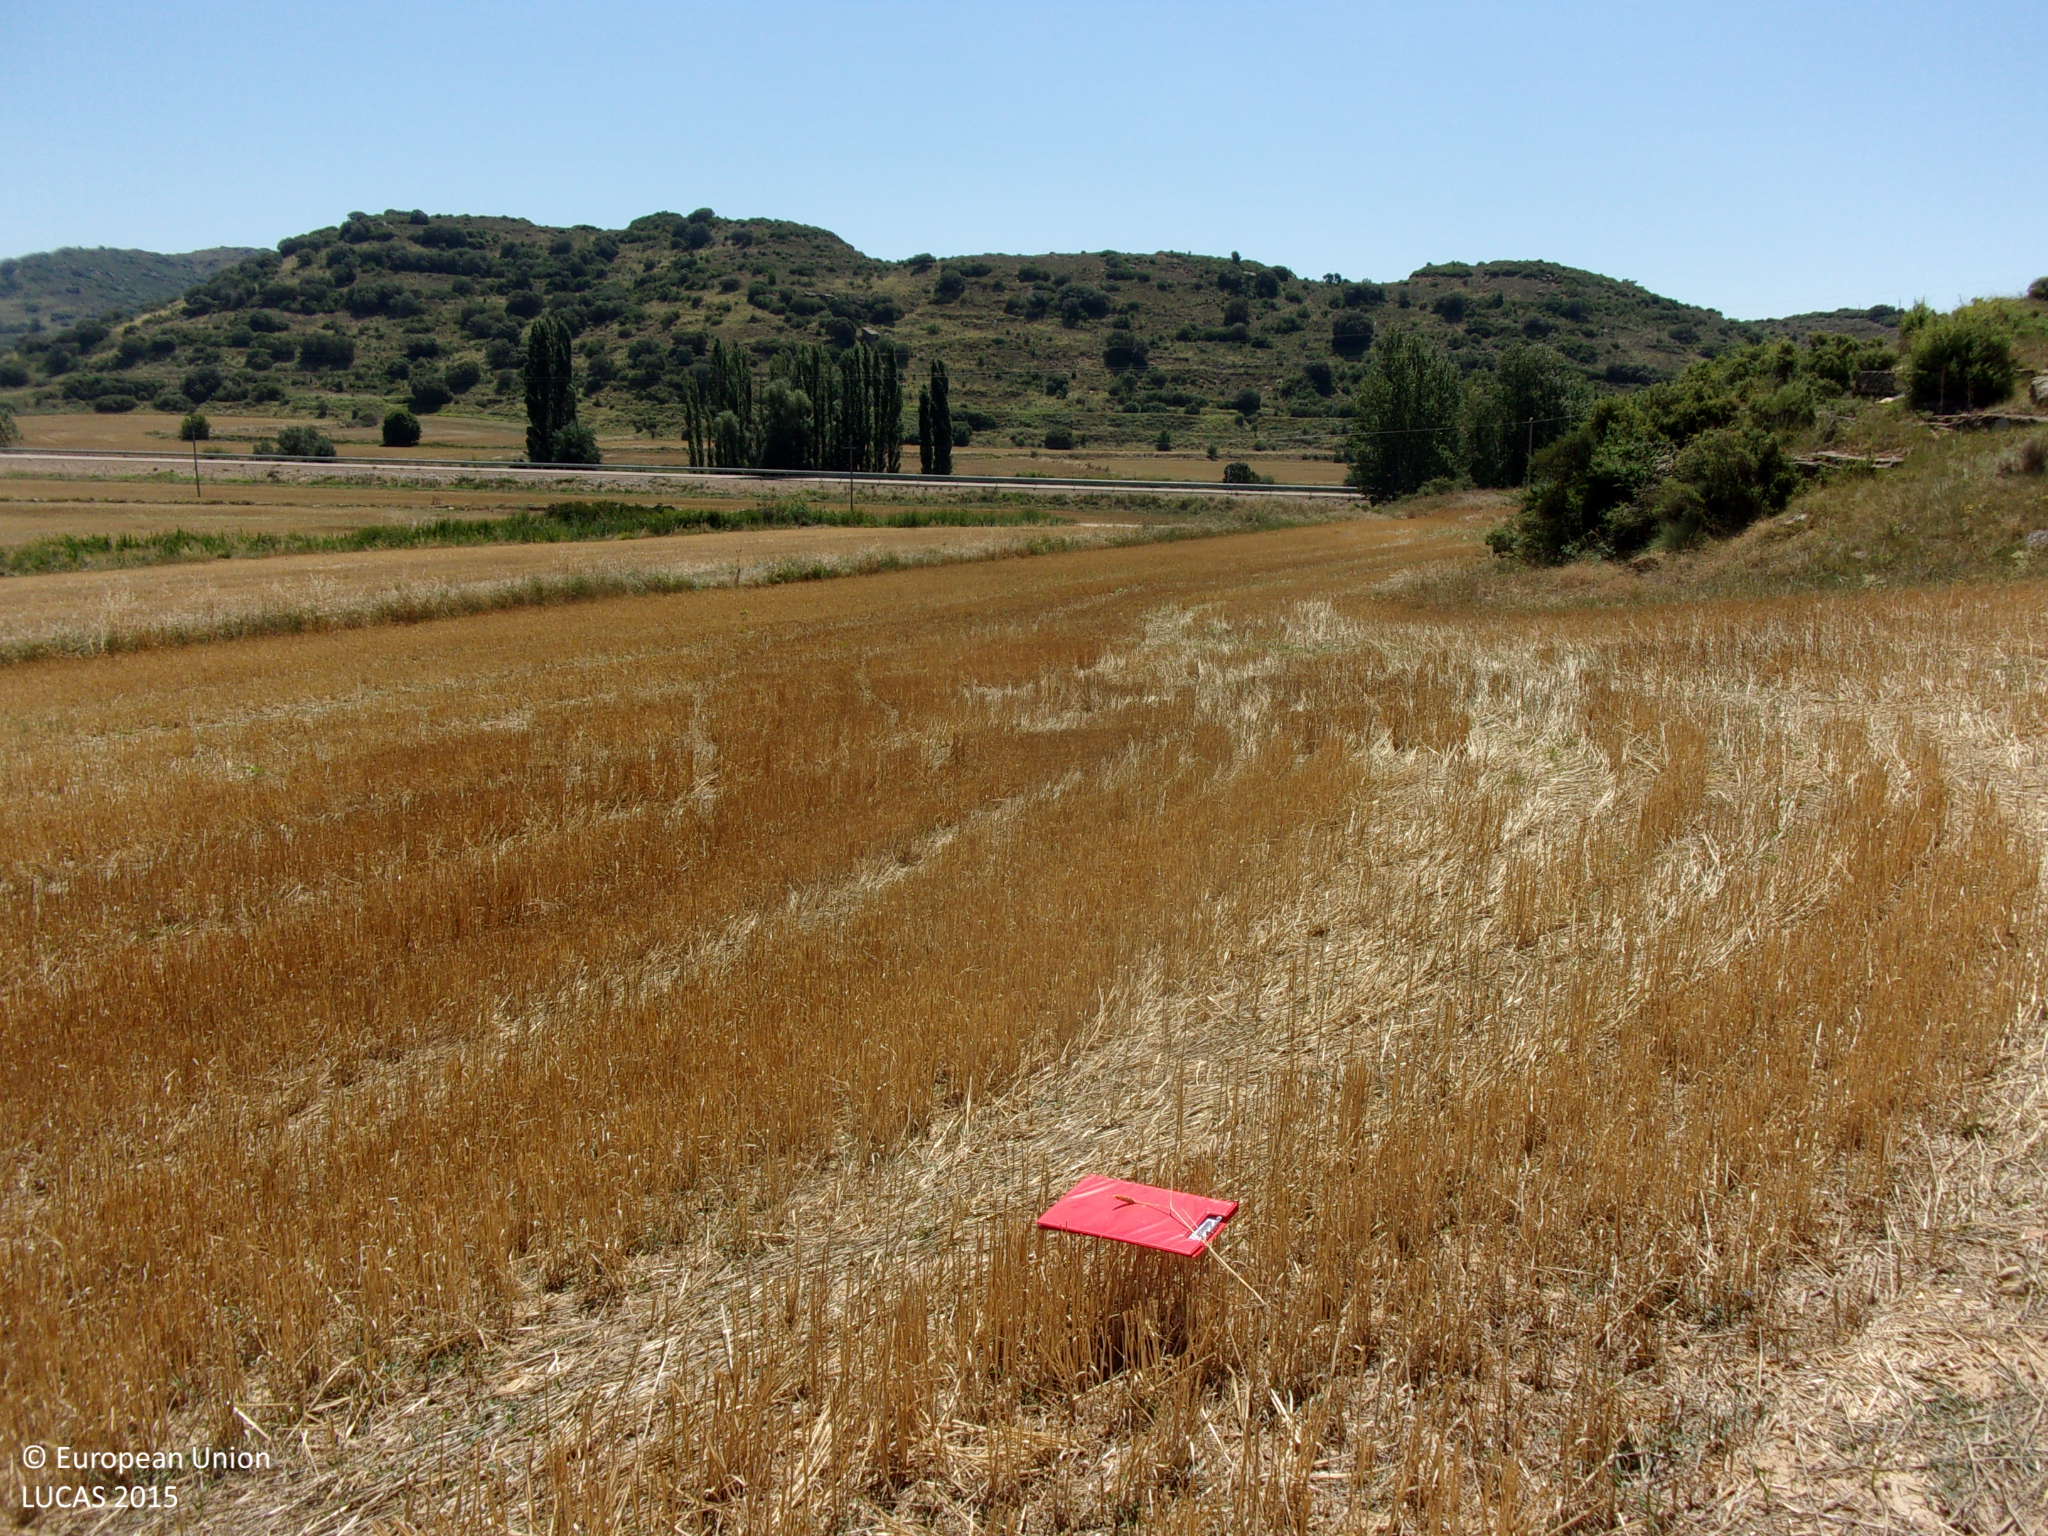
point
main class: Cropland
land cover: Common wheat
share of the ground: < 10 %
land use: Agriculture (excluding fallow land and kitchen gardens)
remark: Harvested field
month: August
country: ES
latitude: 42.3448
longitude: -1.1614
